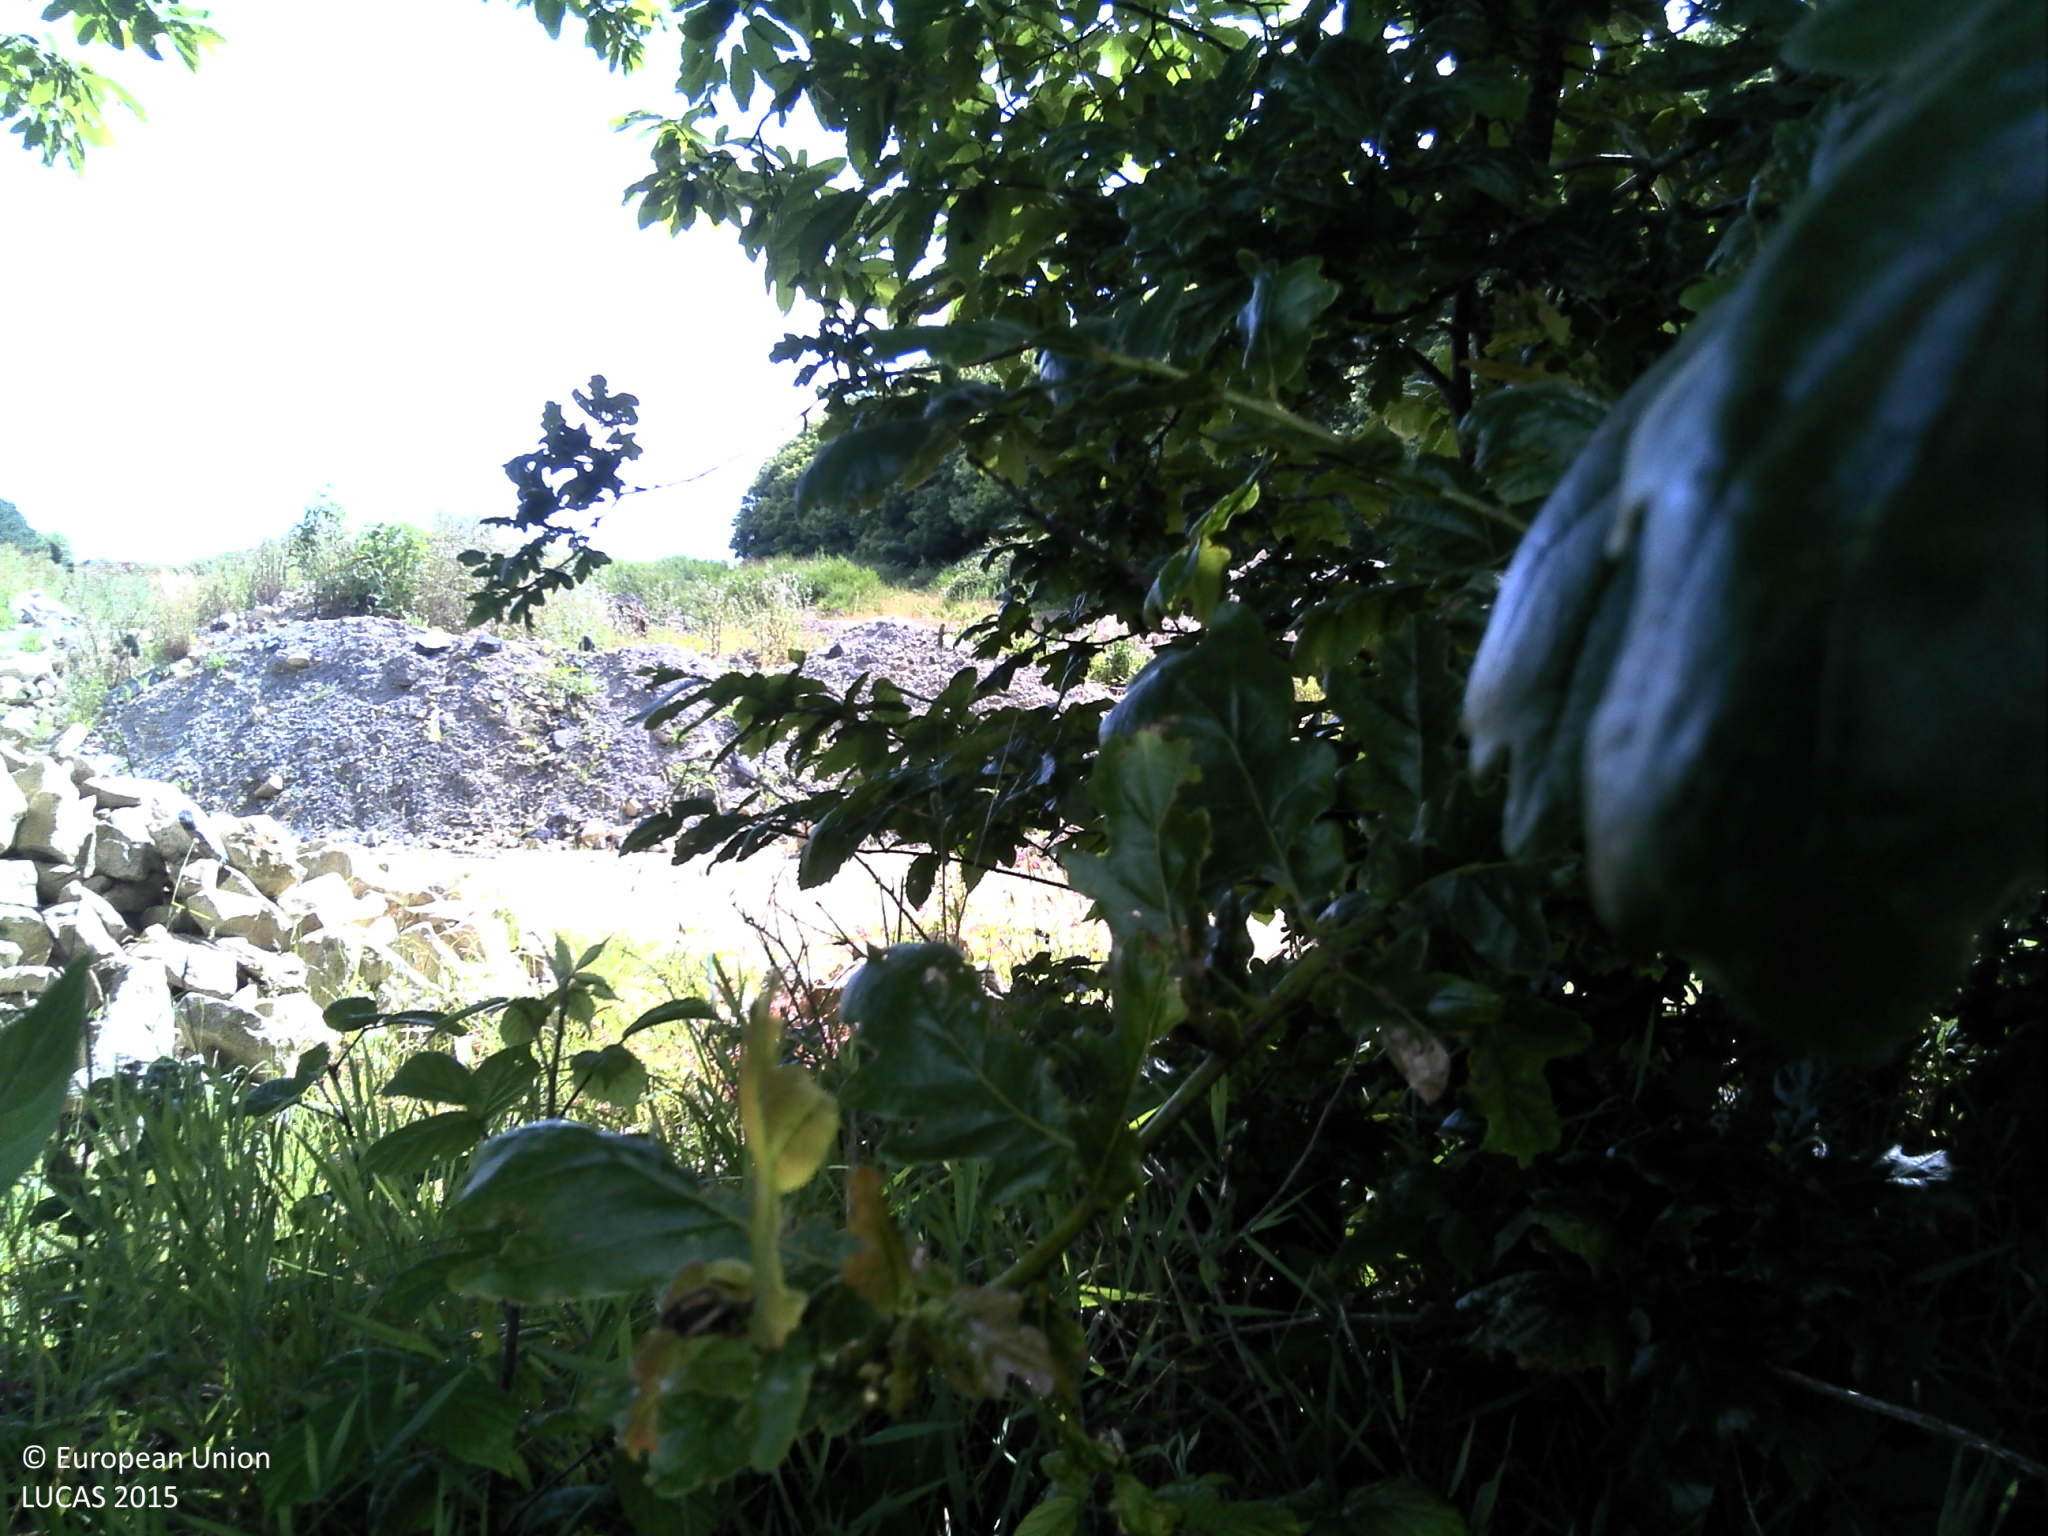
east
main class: Woodland
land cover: Broadleaved woodland
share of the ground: > 75 %
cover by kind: broadleaved forest trees 100 %
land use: Agriculture (excluding fallow land and kitchen gardens)
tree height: > 5 m
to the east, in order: Broadleaved woodland; Other bare soil; Broadleaved woodland; Artificial constructions in urban areas
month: June
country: FR
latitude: 47.9607
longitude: -4.1647
